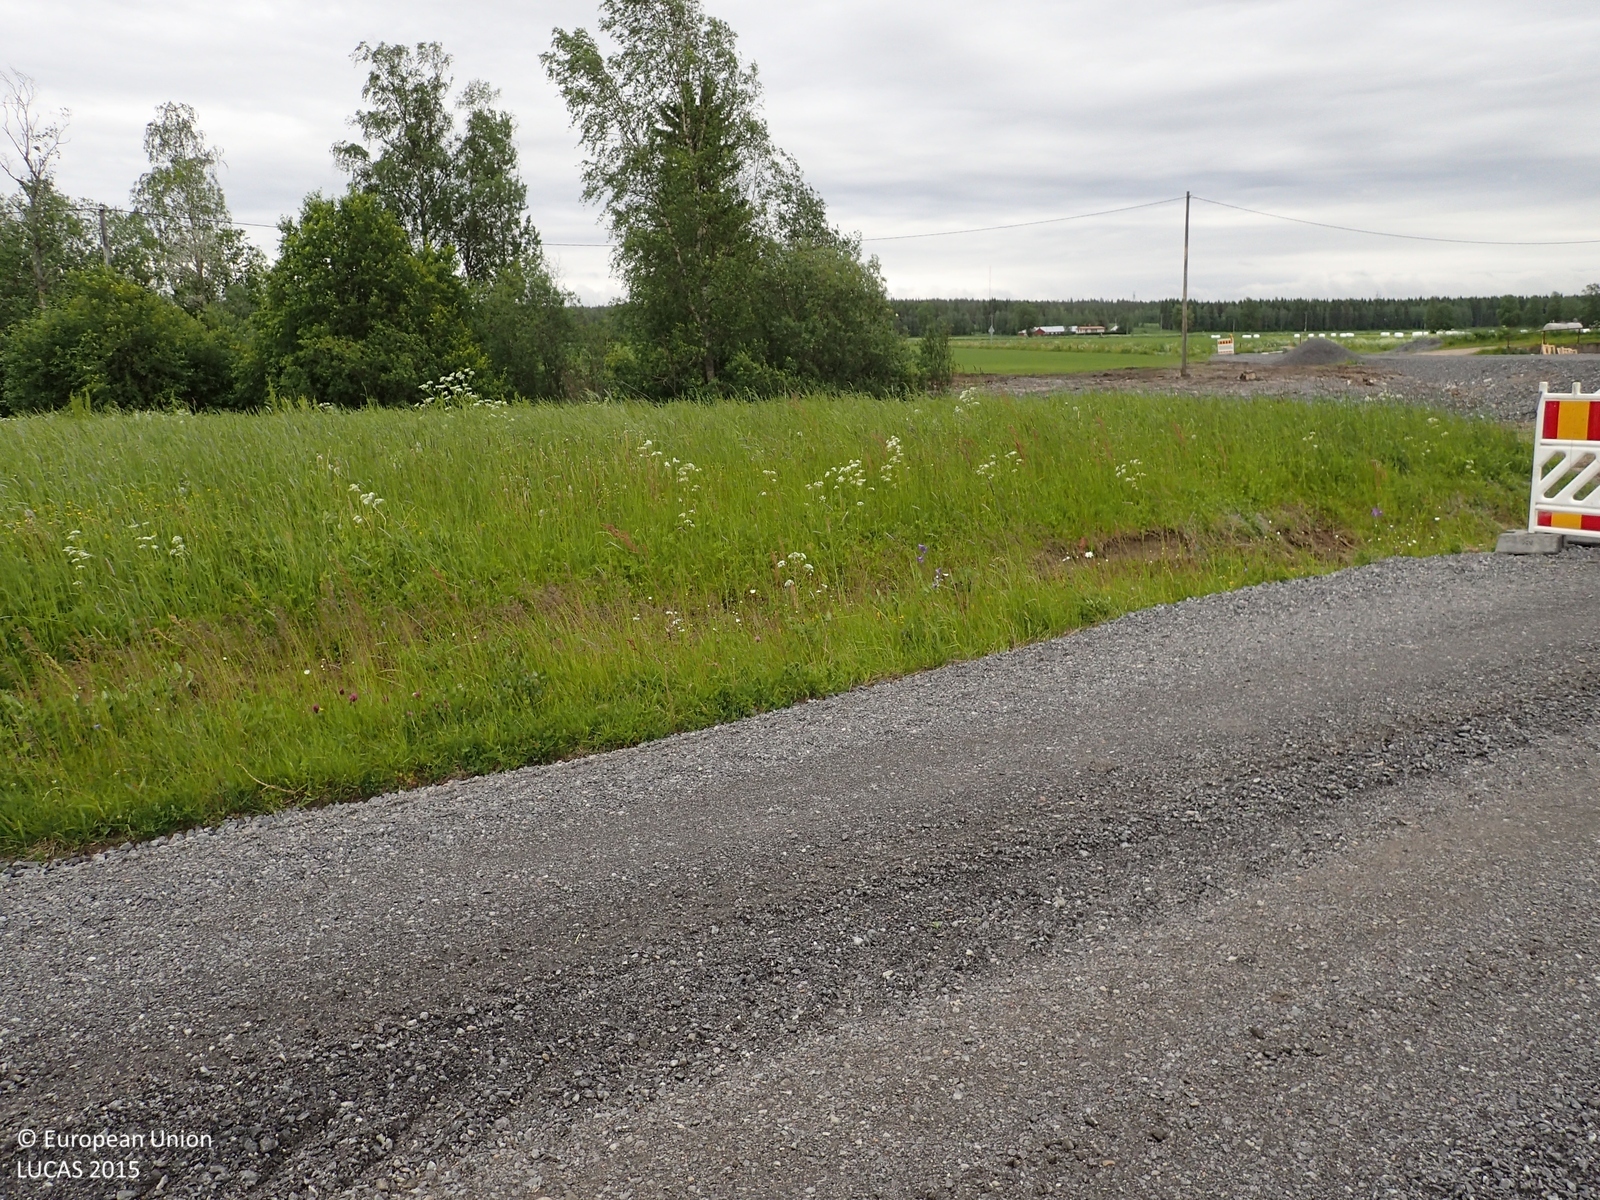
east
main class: Cropland
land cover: Barley
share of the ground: > 75 %
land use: Agriculture (excluding fallow land and kitchen gardens)
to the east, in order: Barley; Shruby margins; Ditches and canals; Shruby margins; Paved roads, cycling and walking lanes; Shruby margins; Ditches and canals; Grassland without tree/shrub cover; Electric lines; Broadleaved woodland; Rivers and streams; Broadleaved woodland; Shruby margins; Barley
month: June
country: FI
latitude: 62.3292
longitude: 21.5689
